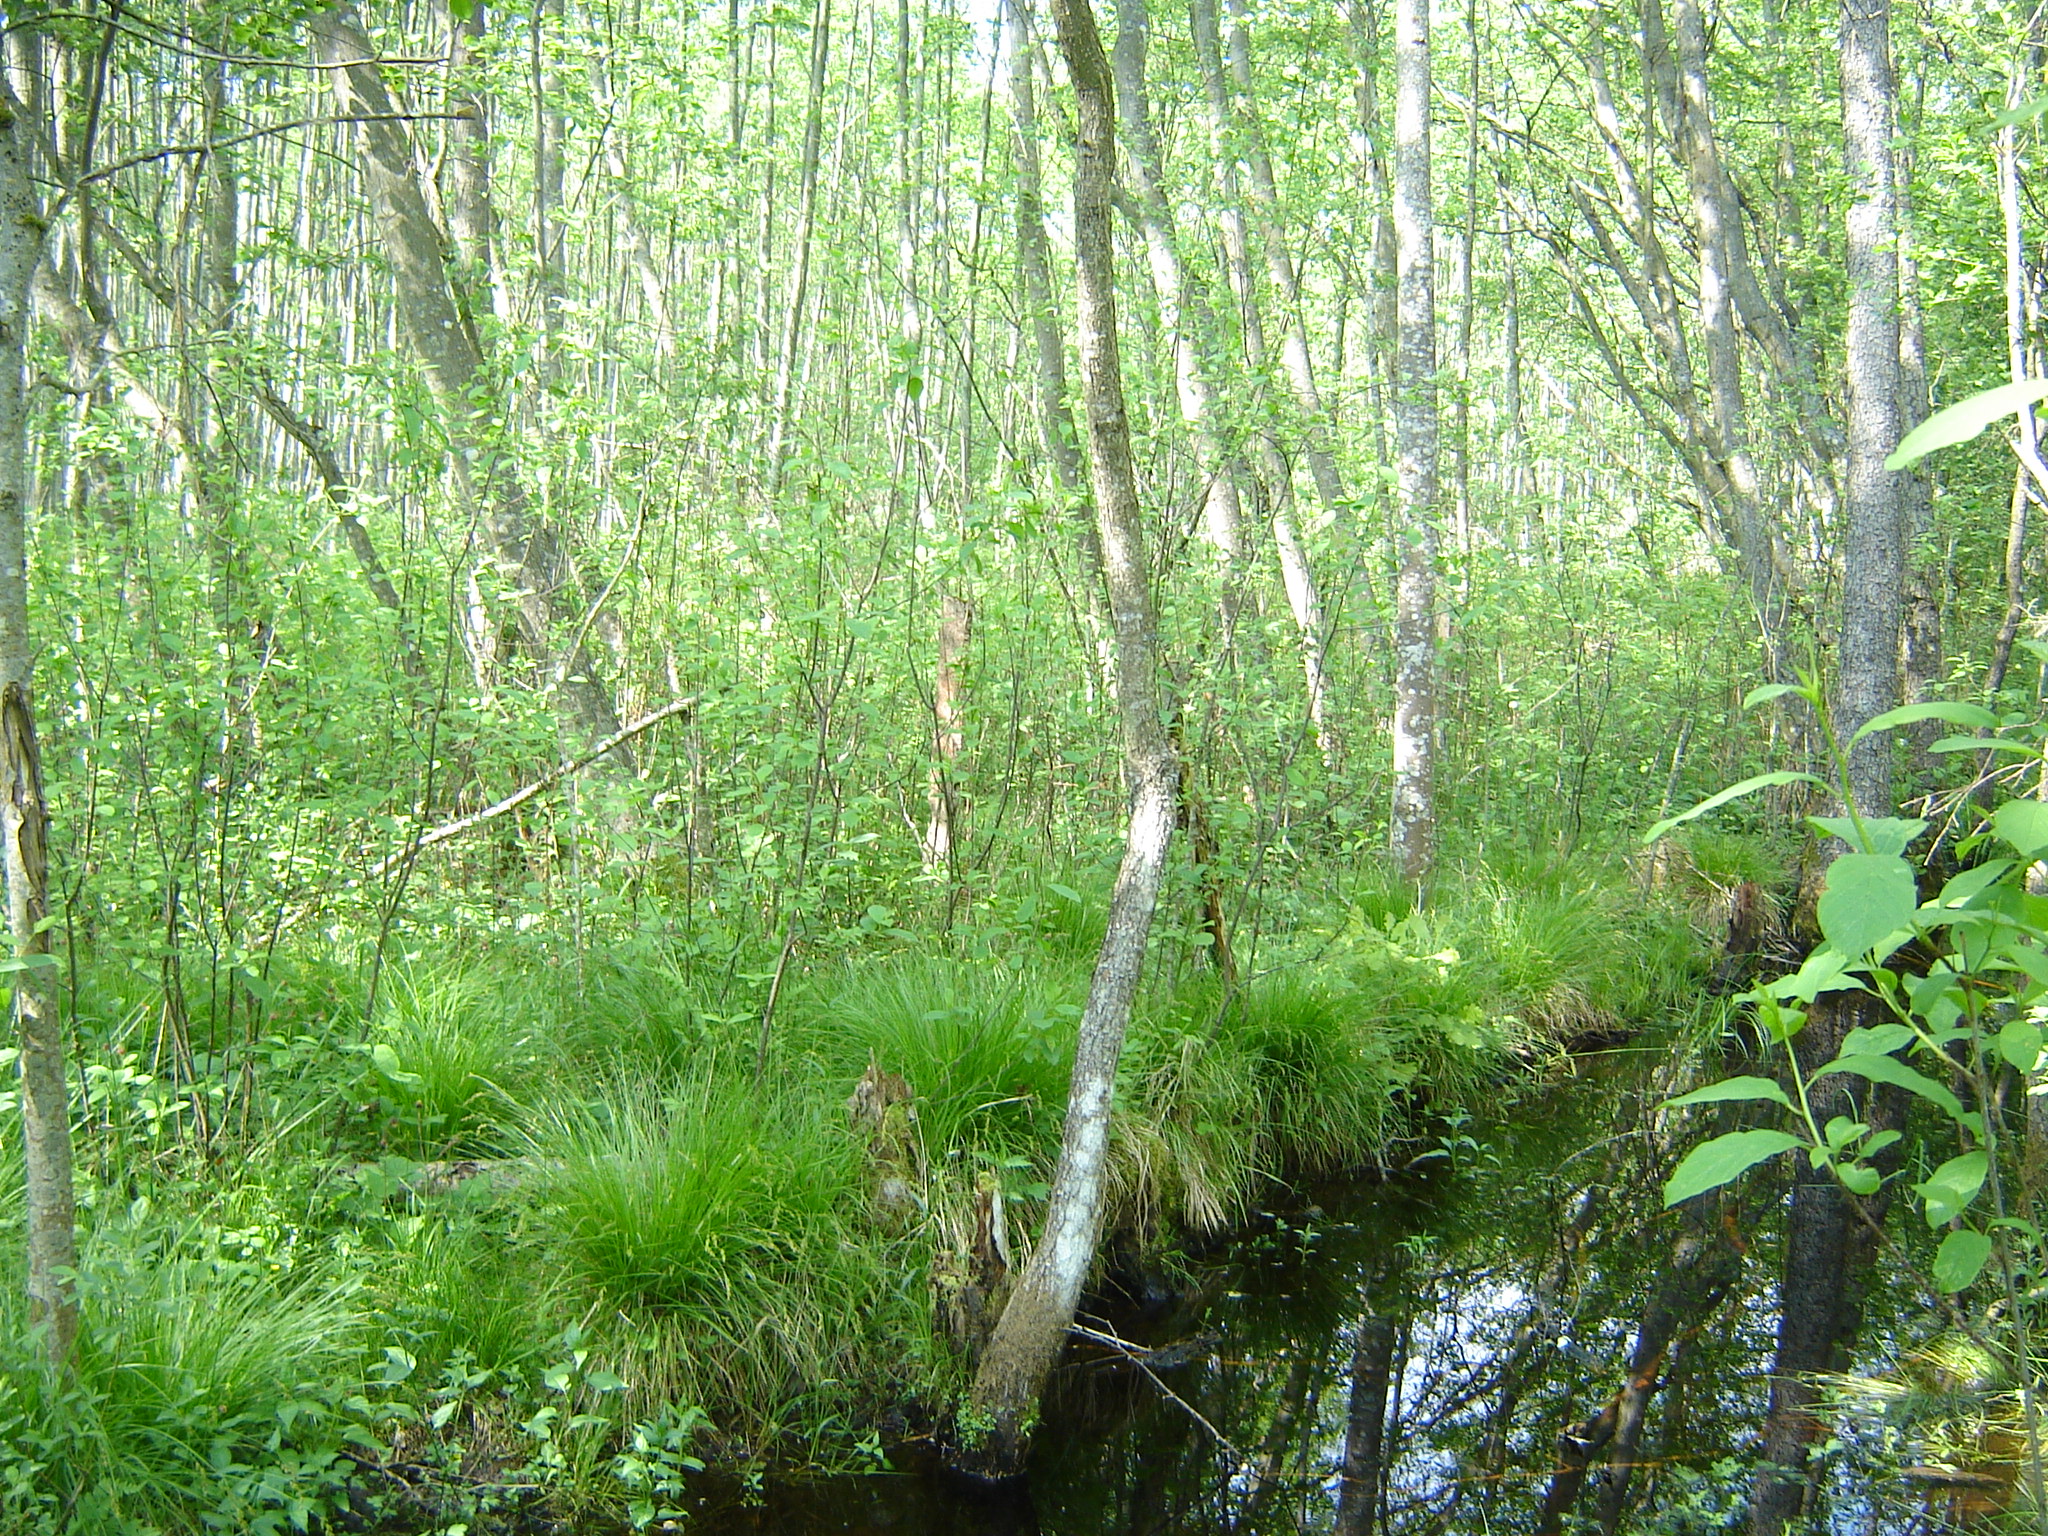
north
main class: Woodland
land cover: Broadleaved woodland
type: floodplain forest
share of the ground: > 75 %
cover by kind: broadleaved forest trees 90 %, herbaceous plants 10 %
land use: Forestry
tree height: > 5 m
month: June
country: LT
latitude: 55.9220
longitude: 25.3041
